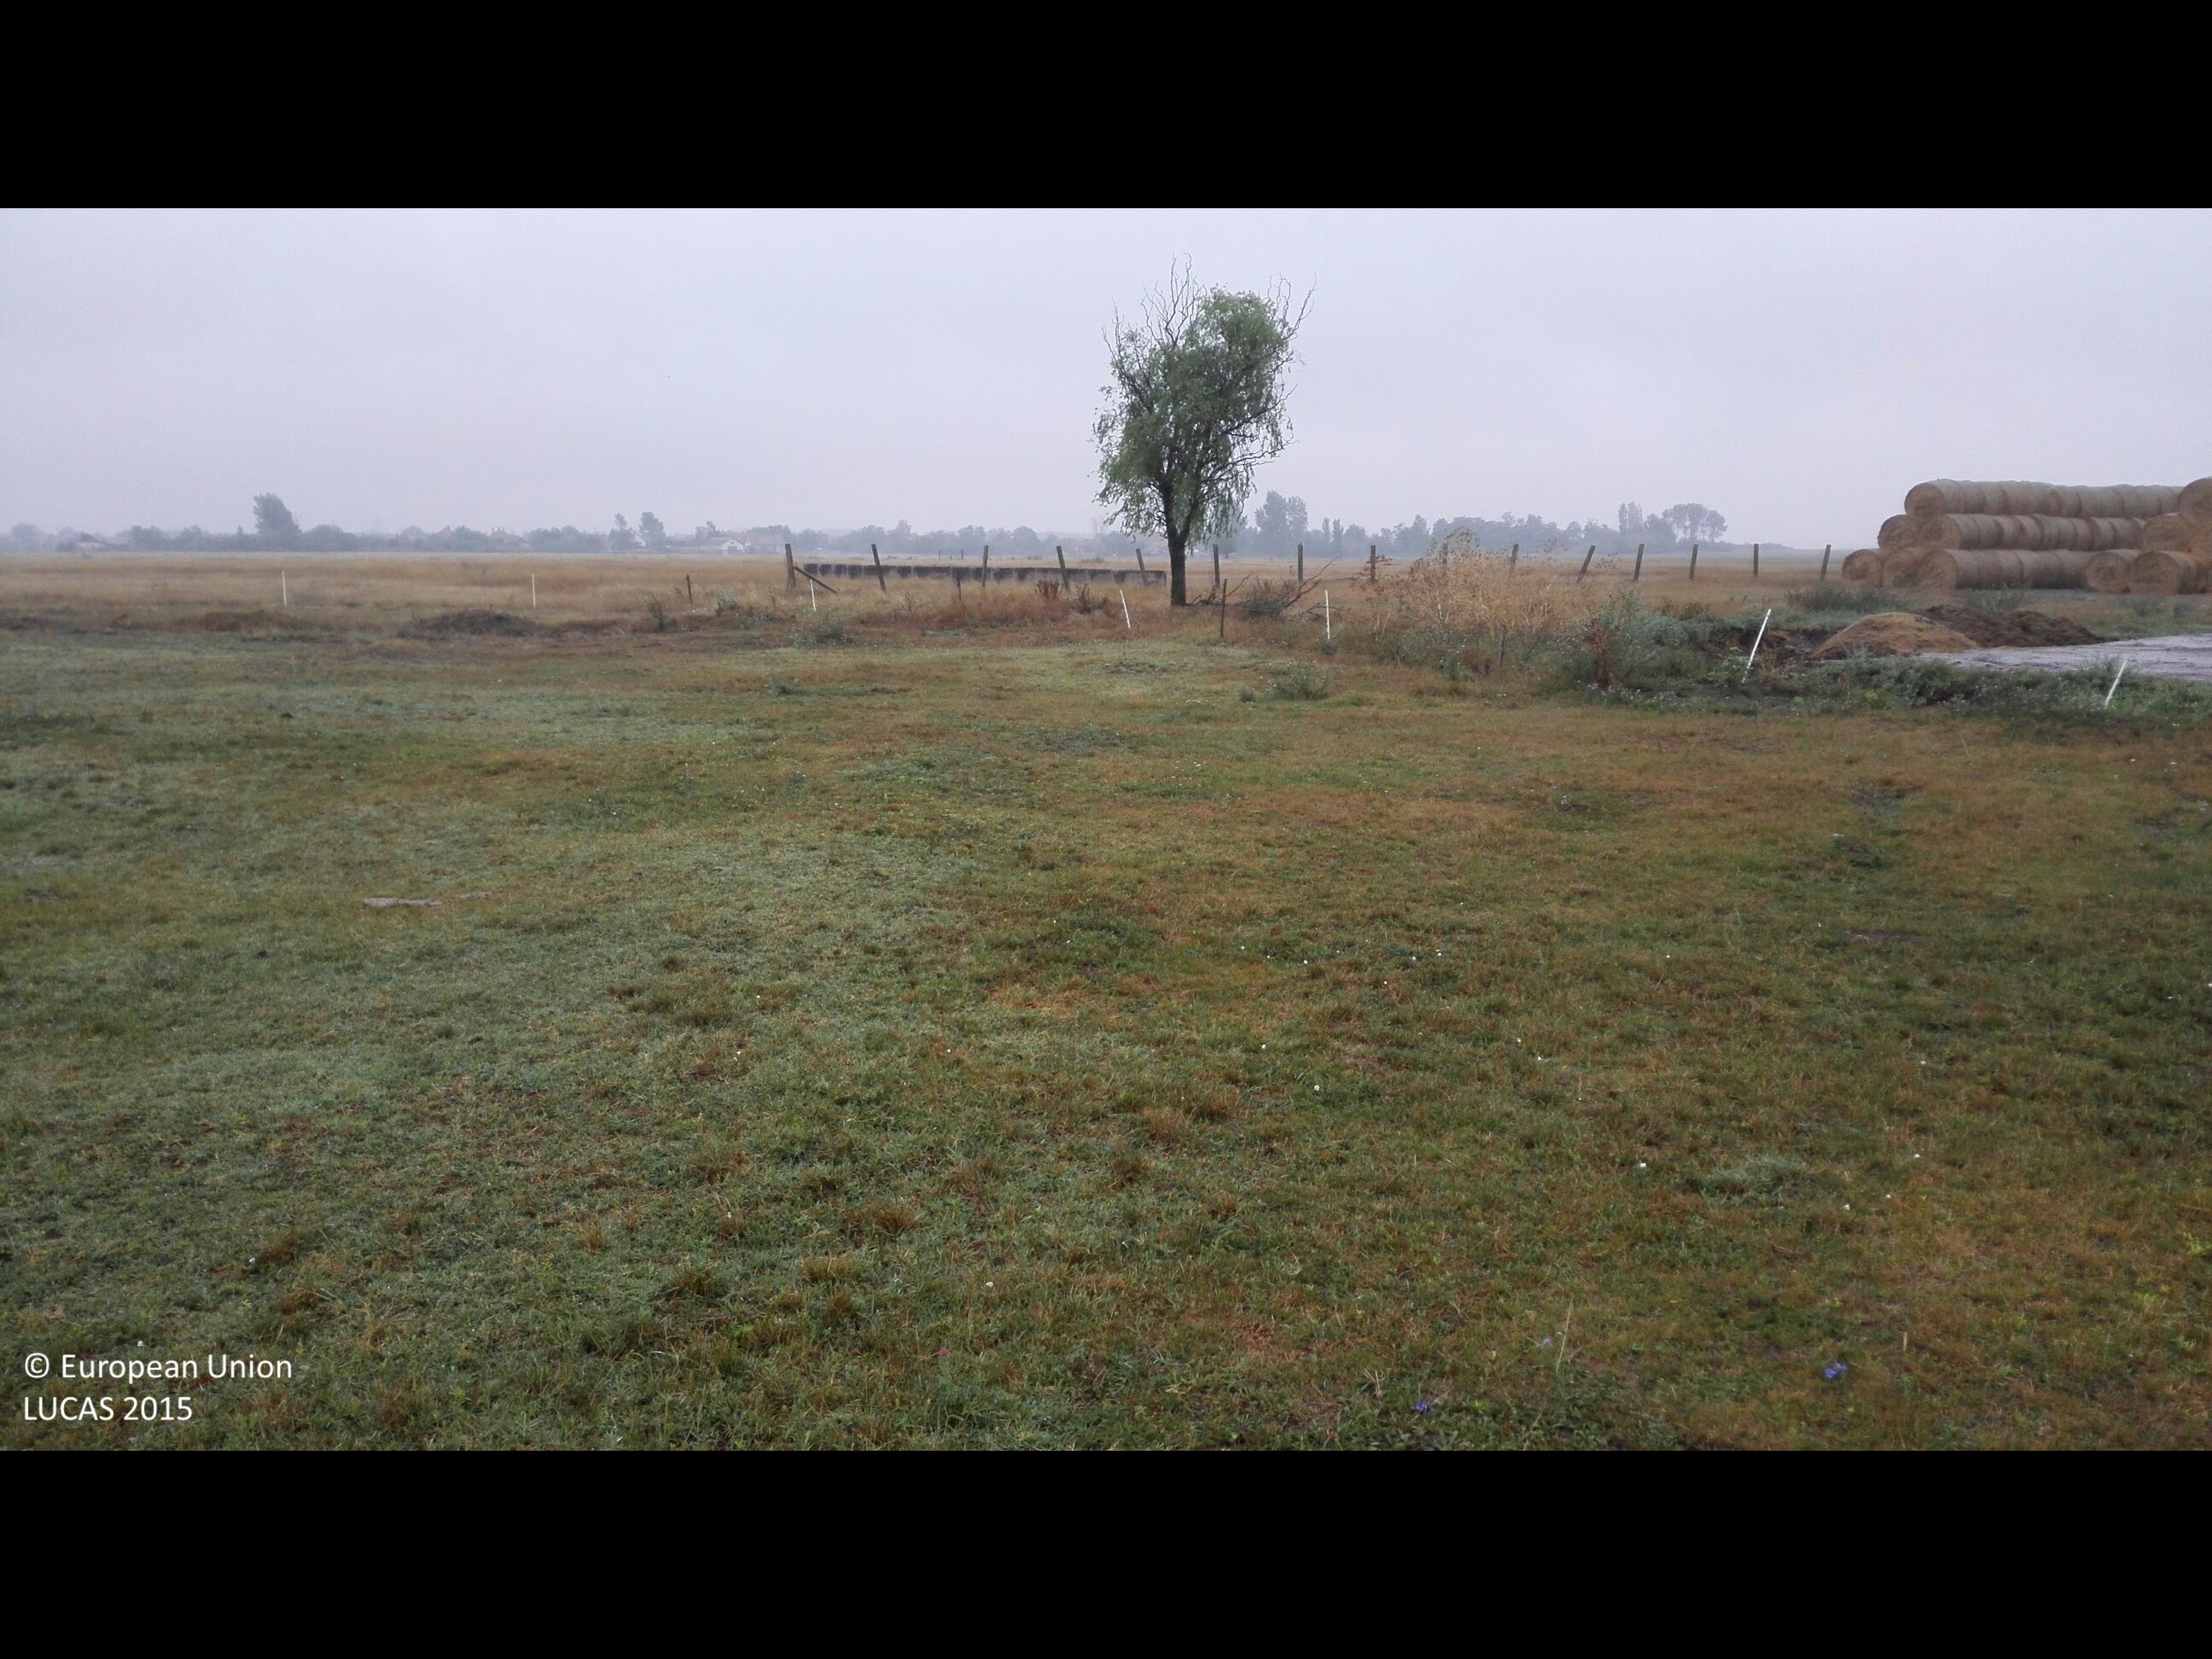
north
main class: Grassland
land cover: Grassland without tree/shrub cover
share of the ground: > 75 %
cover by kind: herbaceous plants 100 %
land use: Agriculture (excluding fallow land and kitchen gardens)
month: August
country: HU
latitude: 47.1861
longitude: 21.6432
